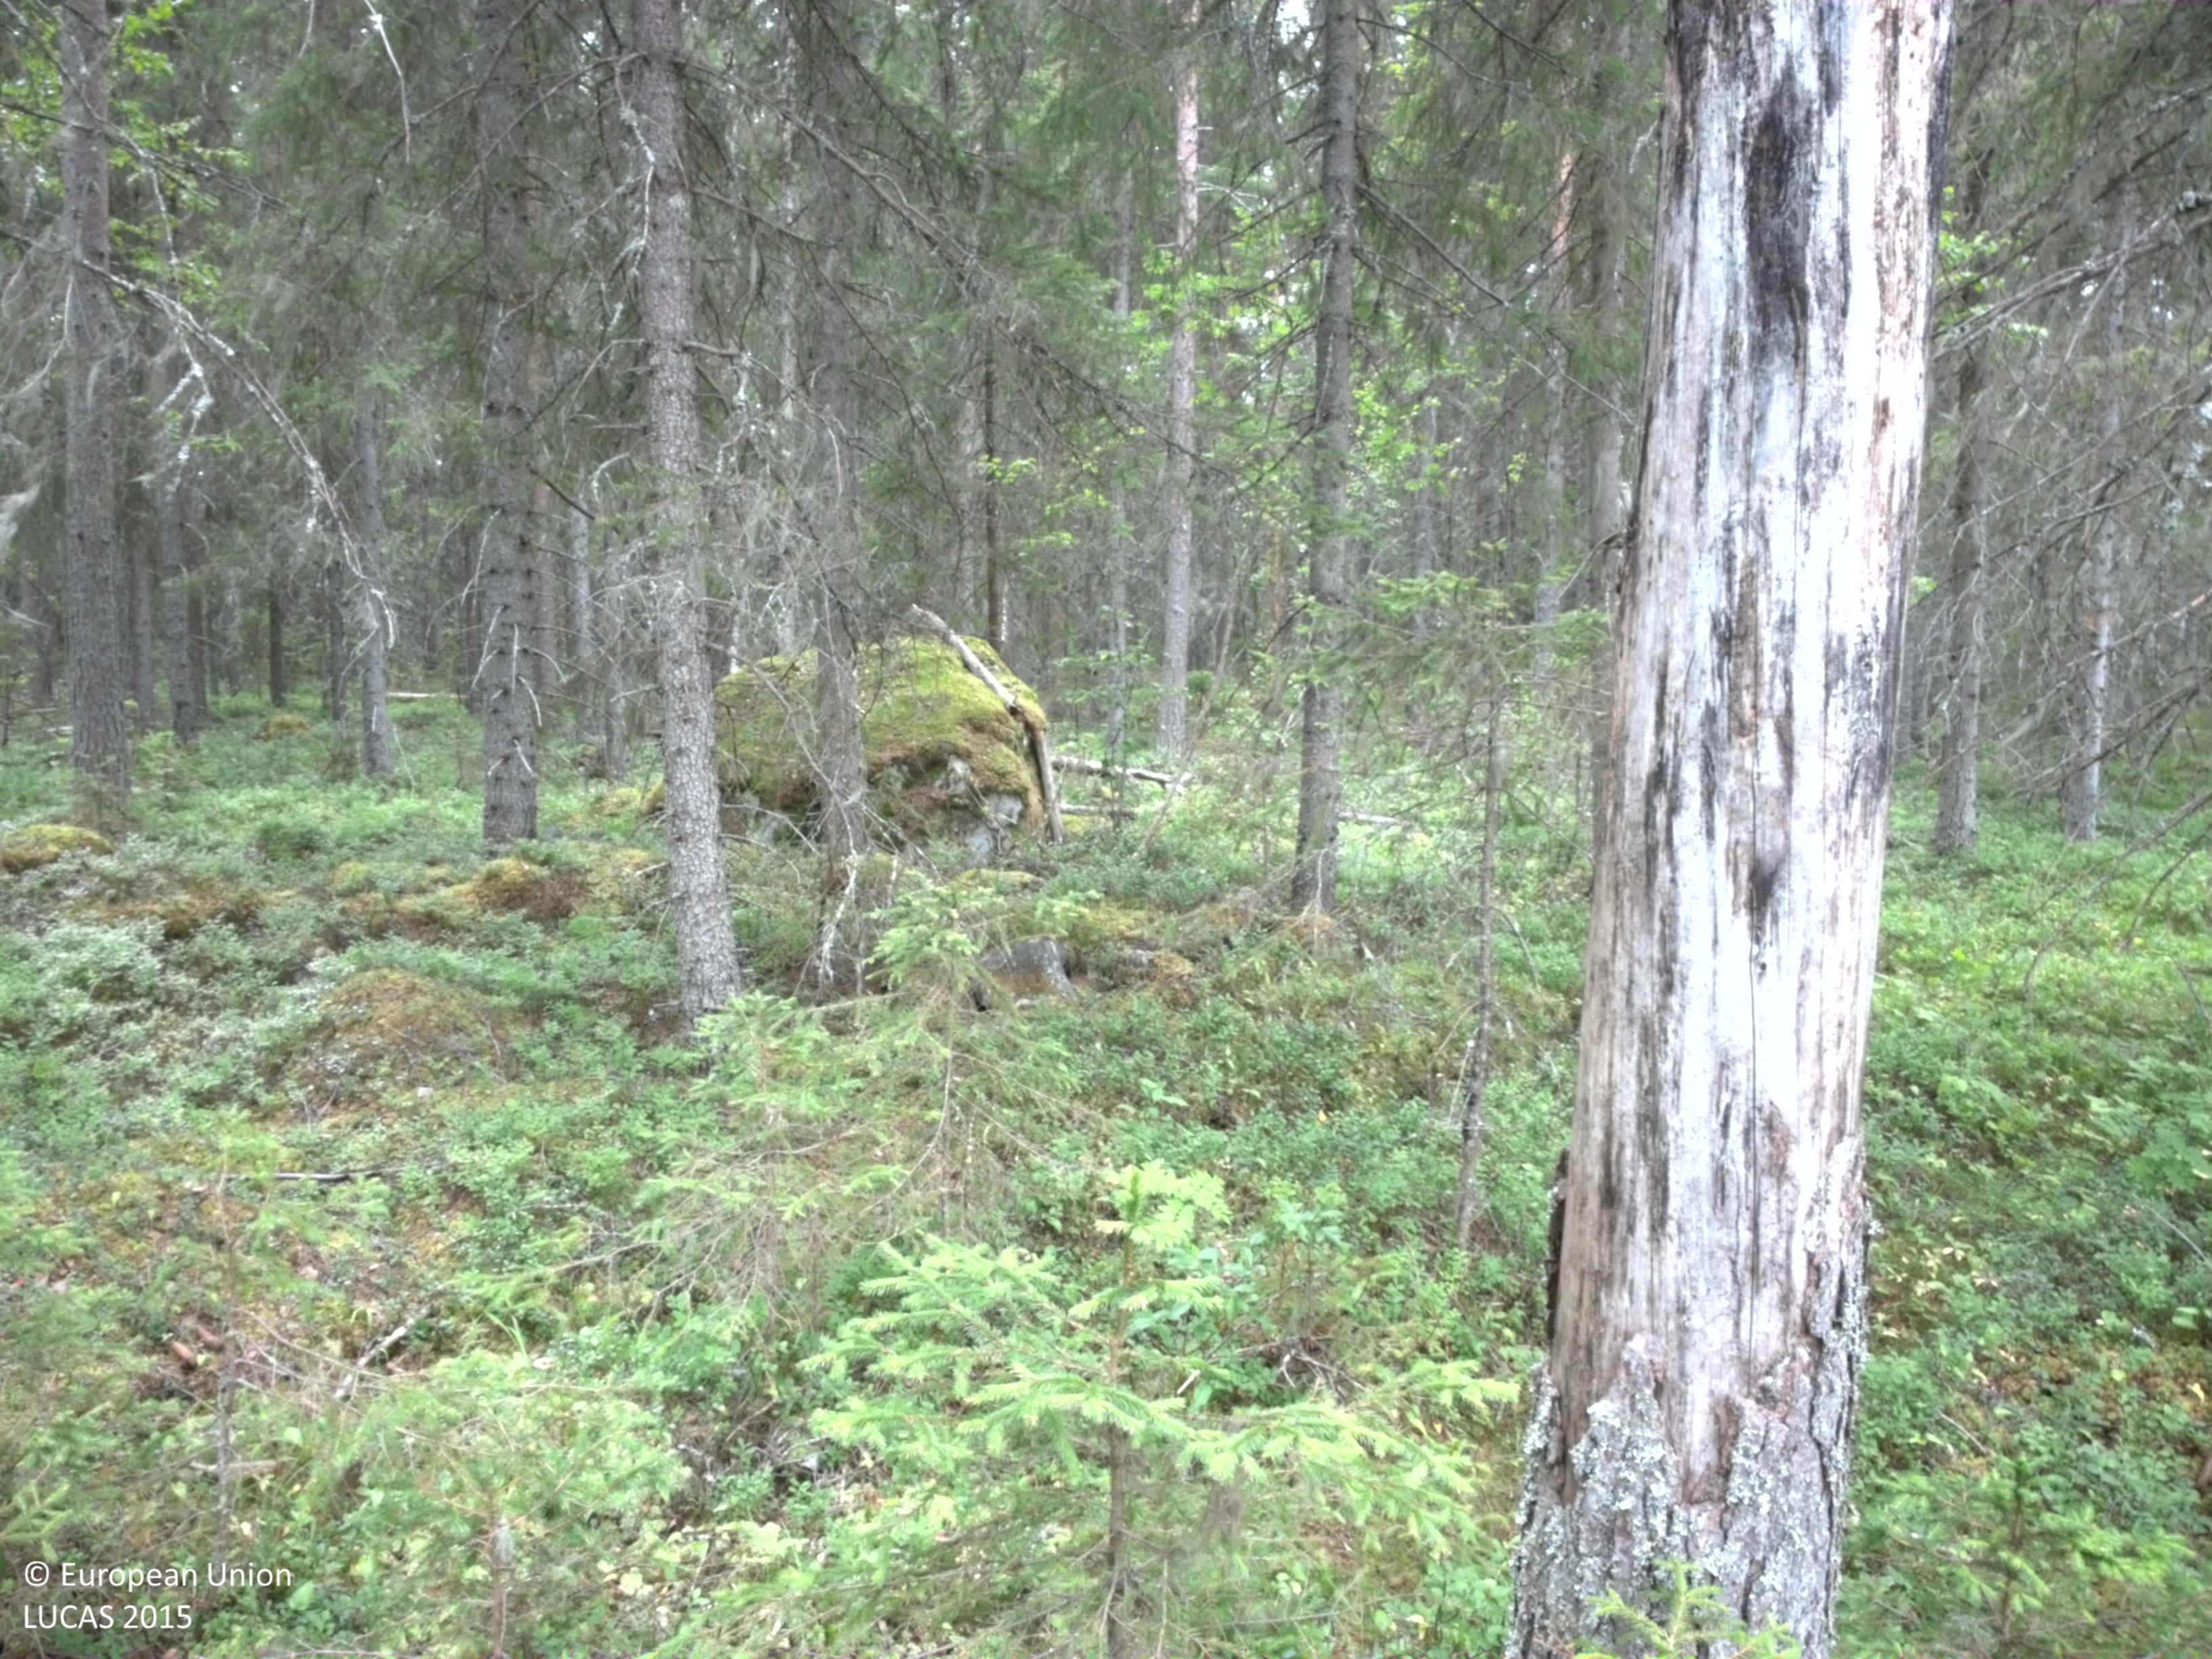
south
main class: Woodland
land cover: Spruce dominated mixed woodland
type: boreal forest
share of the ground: > 75 %
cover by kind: coniferous forest trees 60 %, broadleaved forest trees 20 %, shrubs 20 %
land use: Forestry
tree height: > 5 m
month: August
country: SE
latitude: 64.5402
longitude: 20.7996
